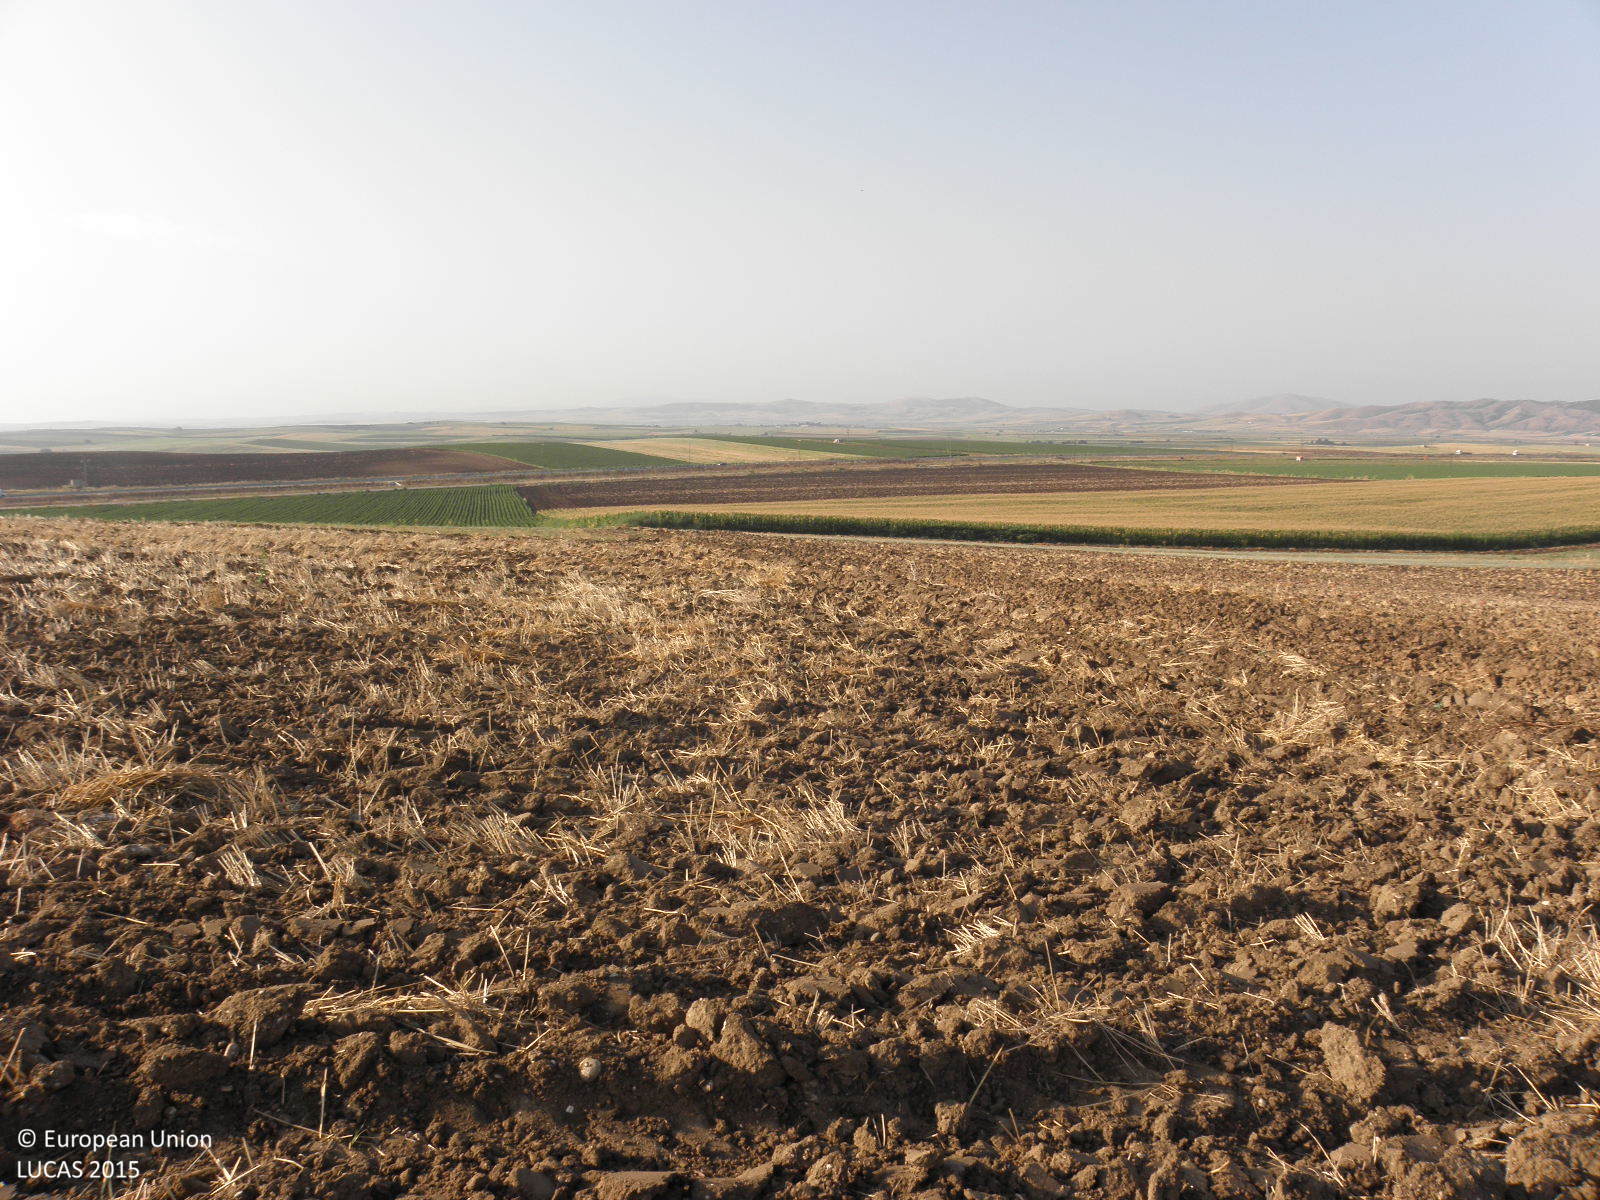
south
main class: Cropland
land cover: Durum wheat
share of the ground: > 75 %
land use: Agriculture (excluding fallow land and kitchen gardens)
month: August
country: GR
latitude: 39.5616
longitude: 22.3138
